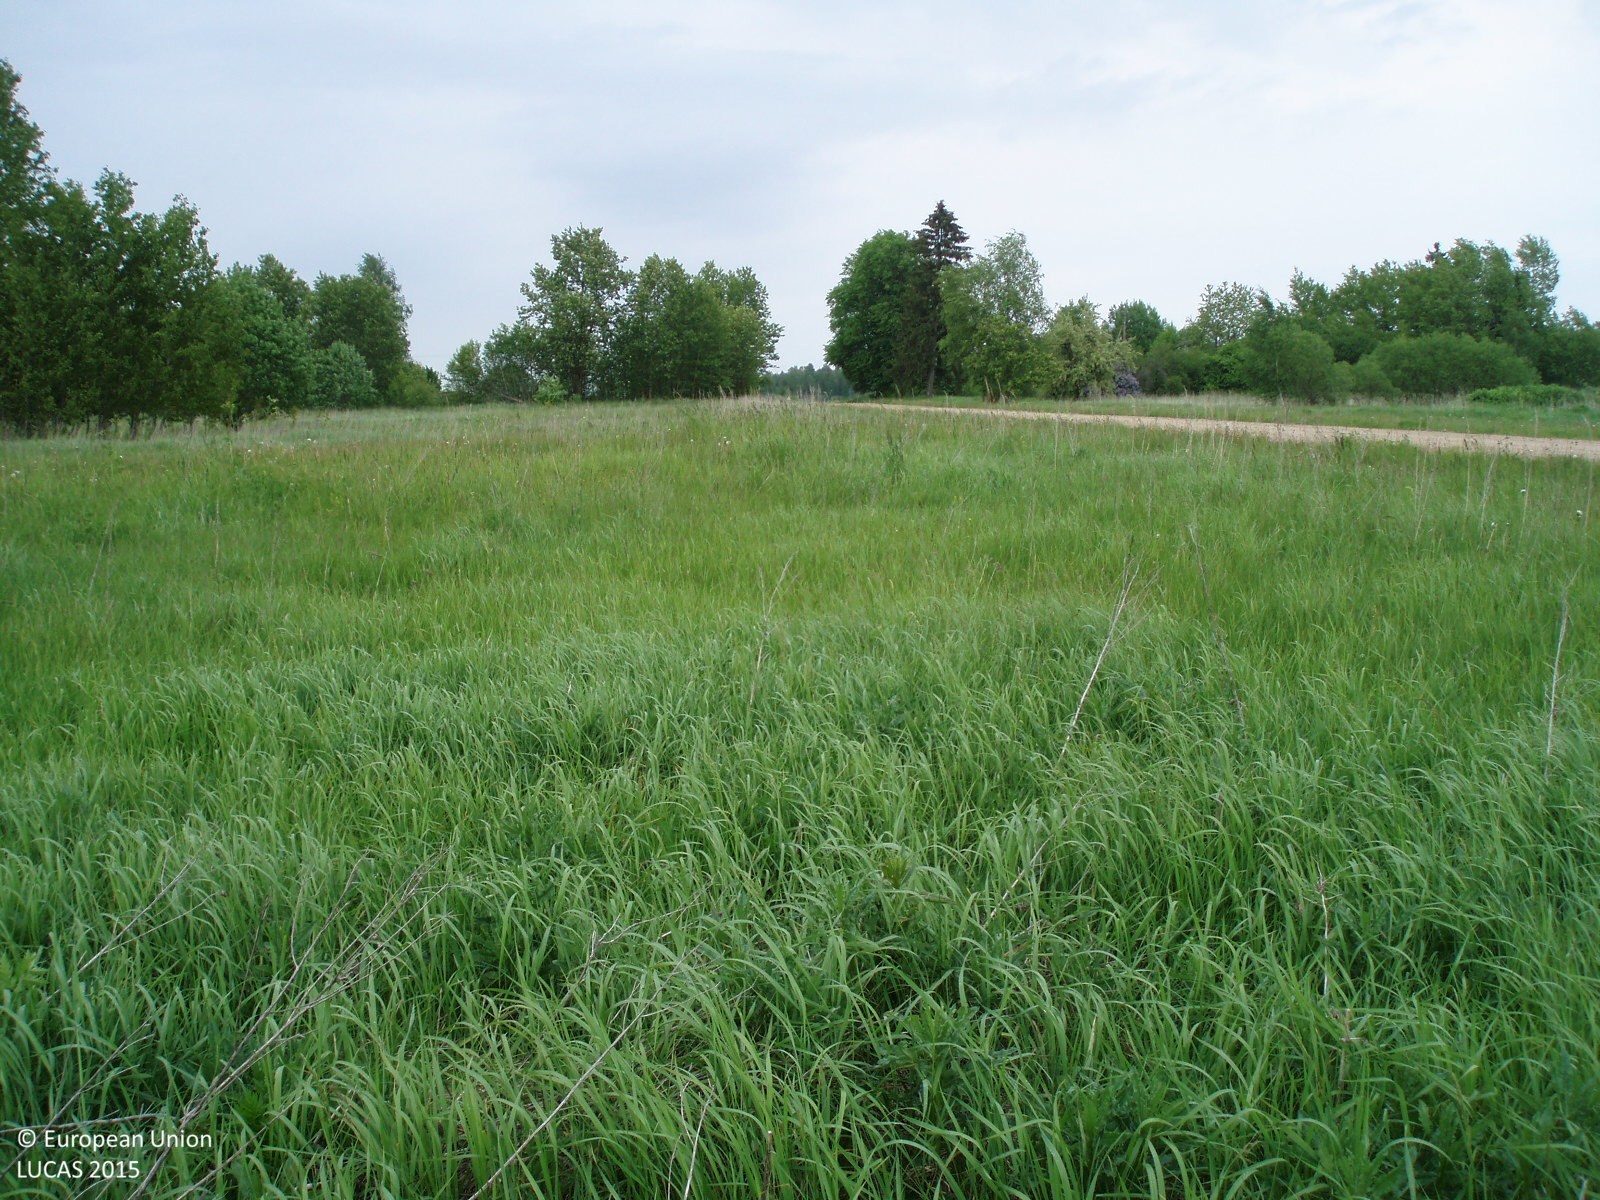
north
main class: Grassland
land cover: Grassland without tree/shrub cover
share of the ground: > 75 %
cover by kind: herbaceous plants 100 %
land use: Agriculture (excluding fallow land and kitchen gardens)
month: May
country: LT
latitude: 56.1177
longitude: 22.5241
